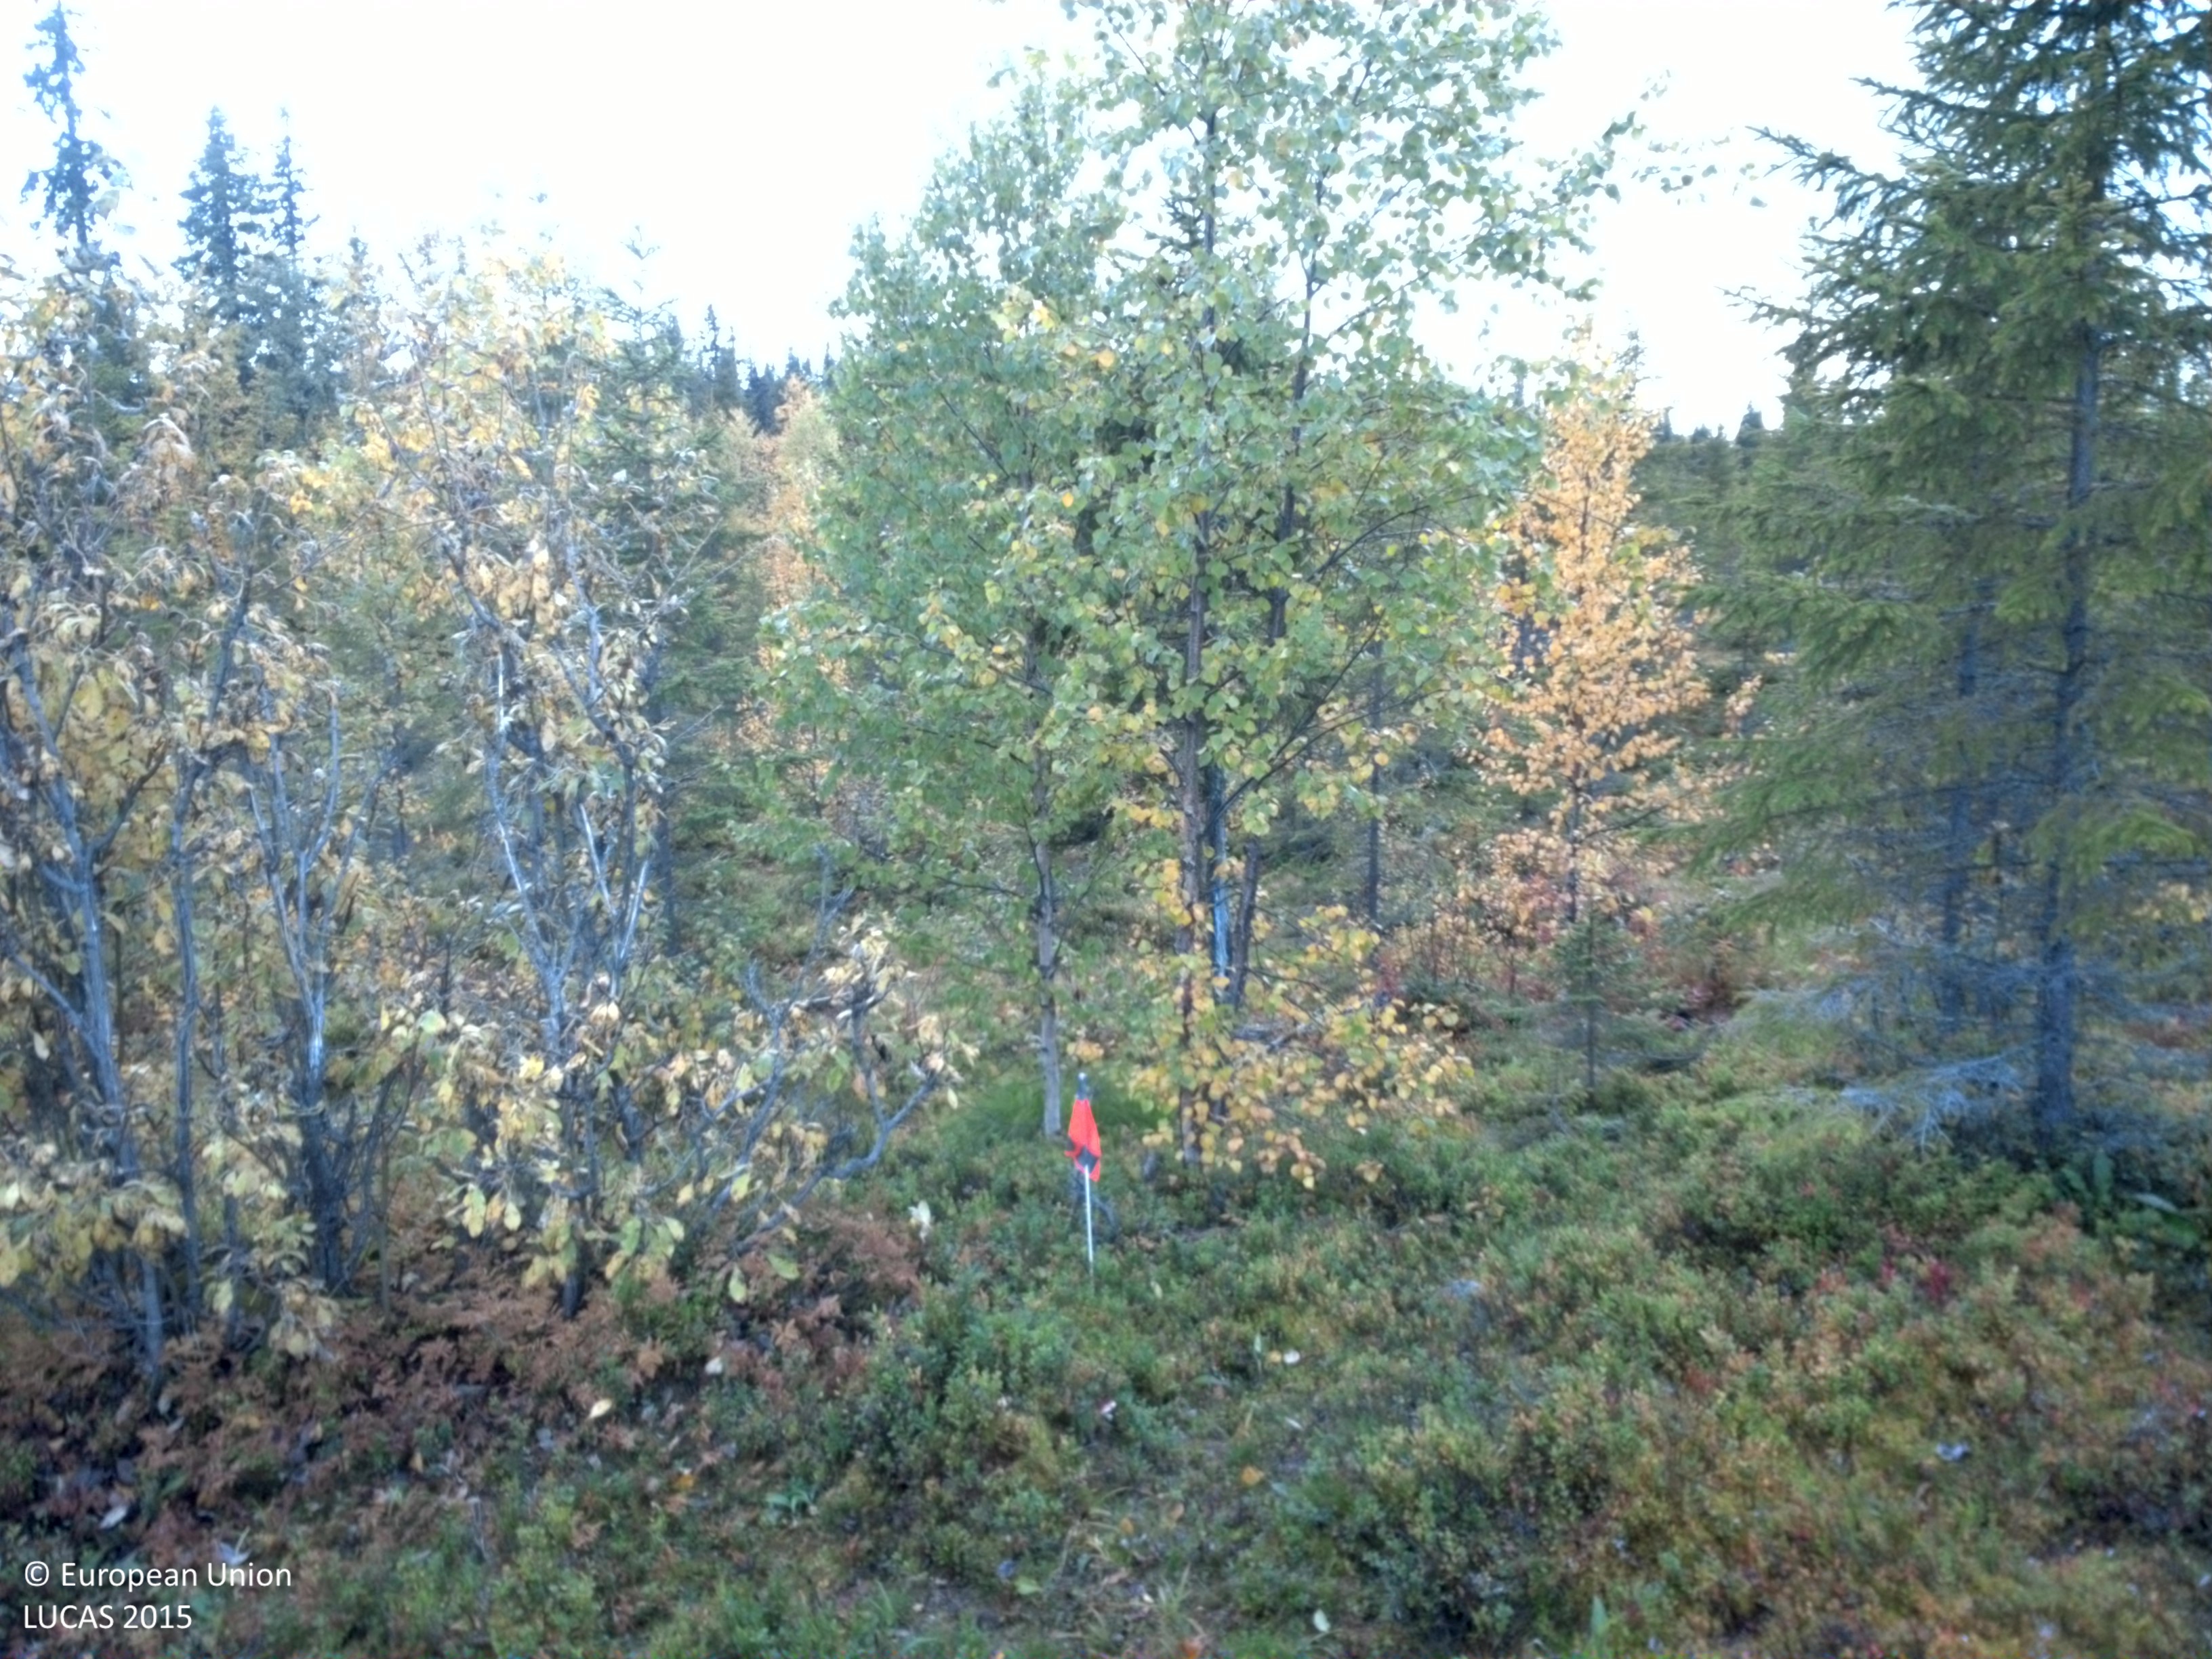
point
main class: Woodland
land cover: Spruce dominated mixed woodland
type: boreal forest
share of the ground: 10 - 25 %
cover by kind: shrubs 50 %, coniferous forest trees 15 %, herbaceous plants 15 %, lichens and mosses 15 %, broadleaved forest trees 5 %
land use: Forestry
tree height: > 5 m
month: September
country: SE
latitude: 65.0620
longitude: 16.9567
